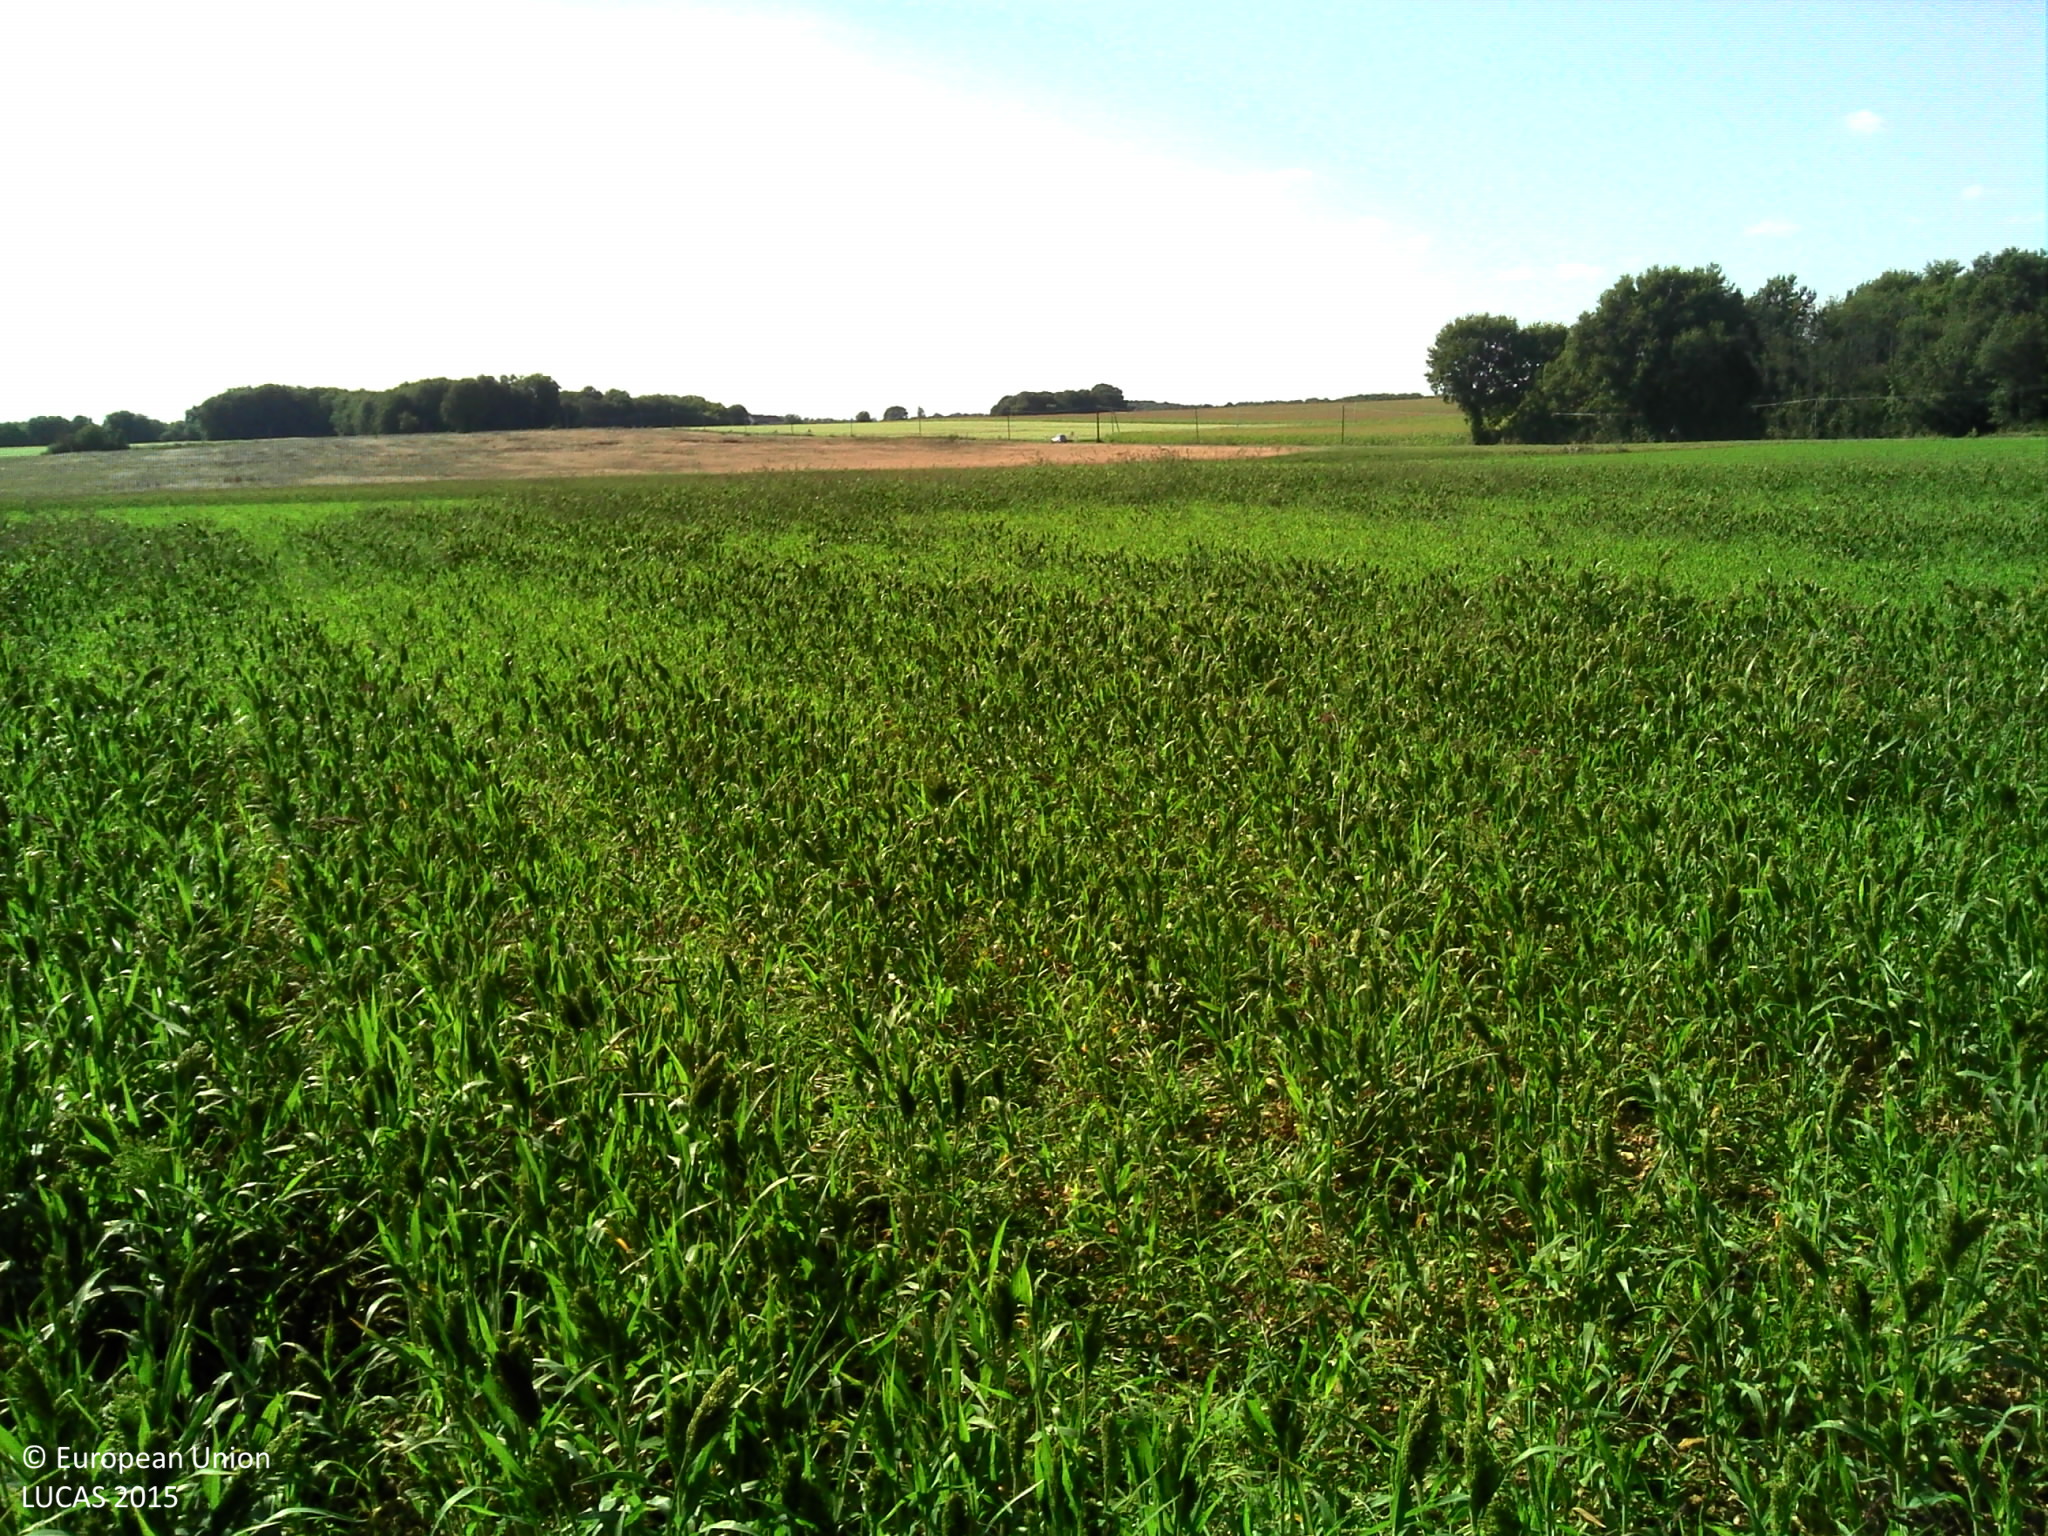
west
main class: Cropland
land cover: Other cereals
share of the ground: > 75 %
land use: Agriculture (excluding fallow land and kitchen gardens)
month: September
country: FR
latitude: 46.9746
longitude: 1.0860
